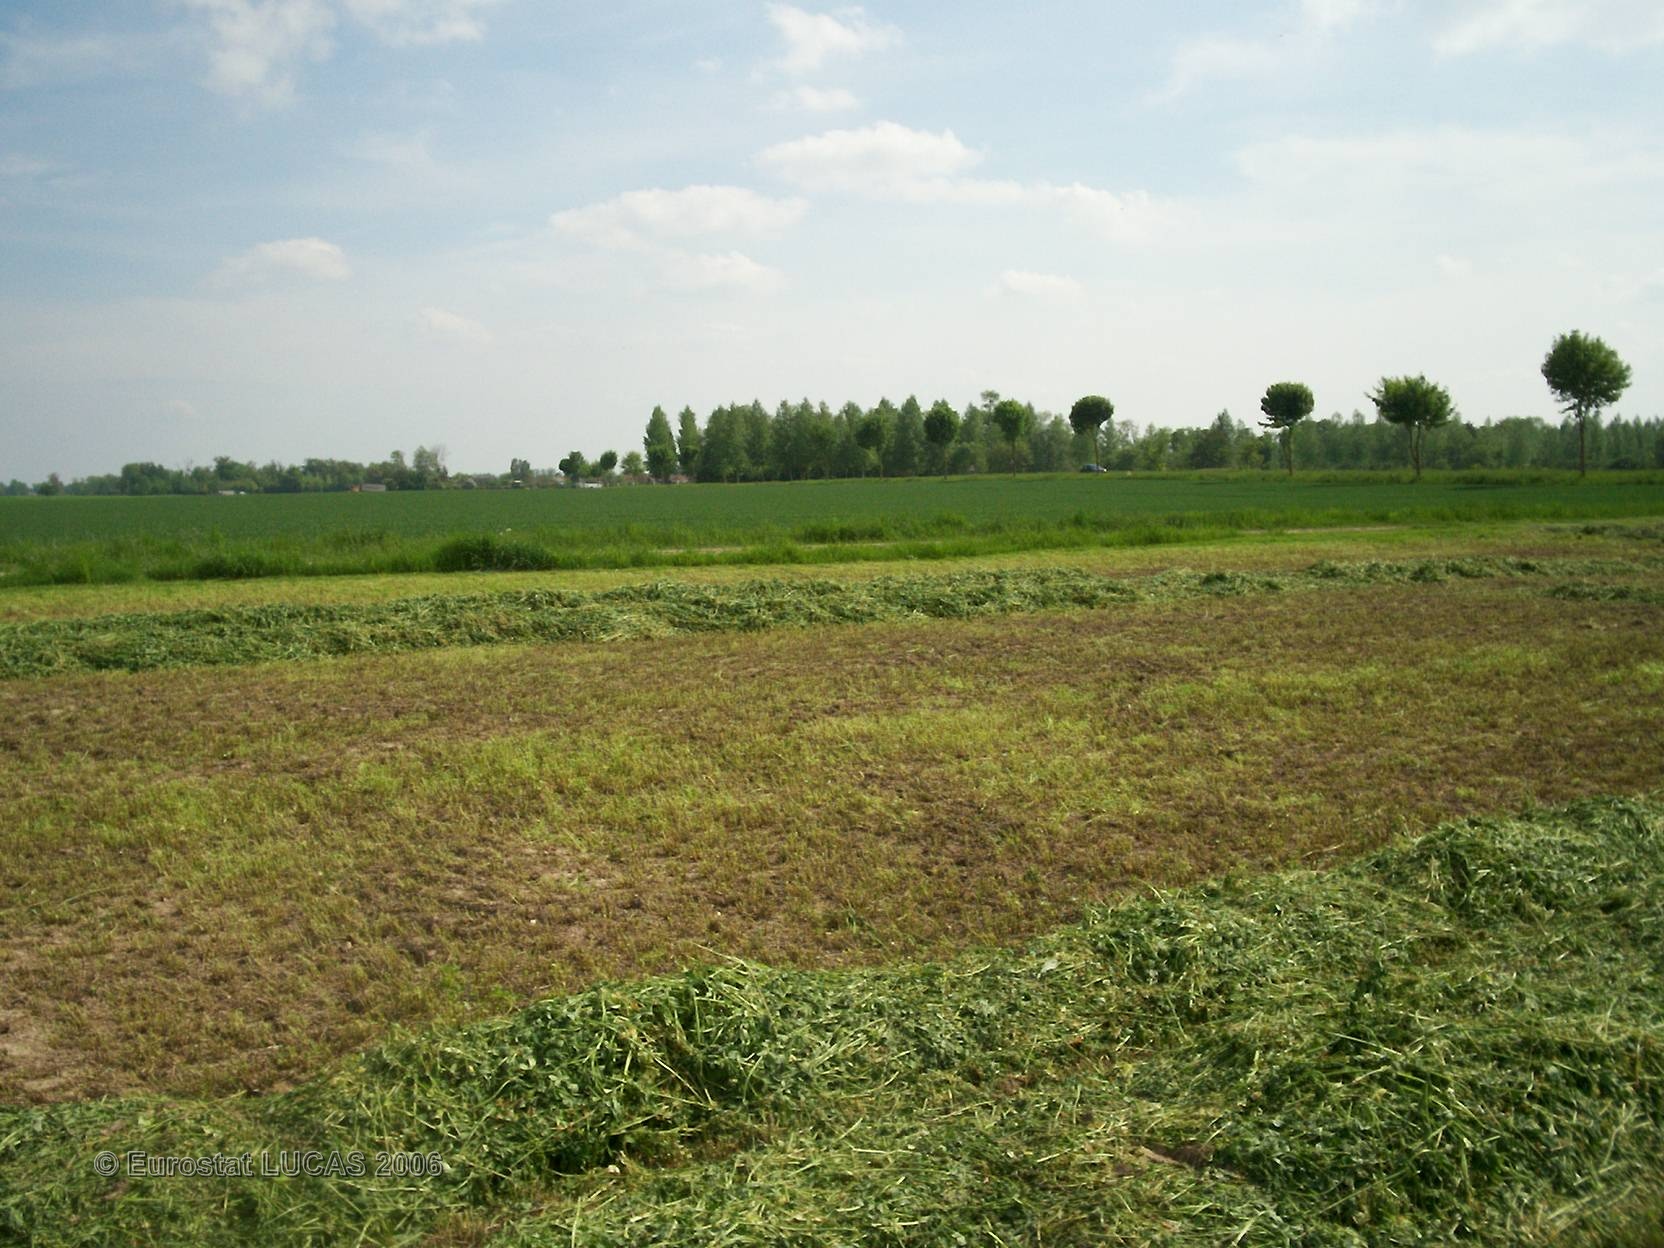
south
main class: Cropland
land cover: Lucerne
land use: Agriculture (excluding fallow land and kitchen gardens)
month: May
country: FR
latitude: 48.8951
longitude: 4.4451
